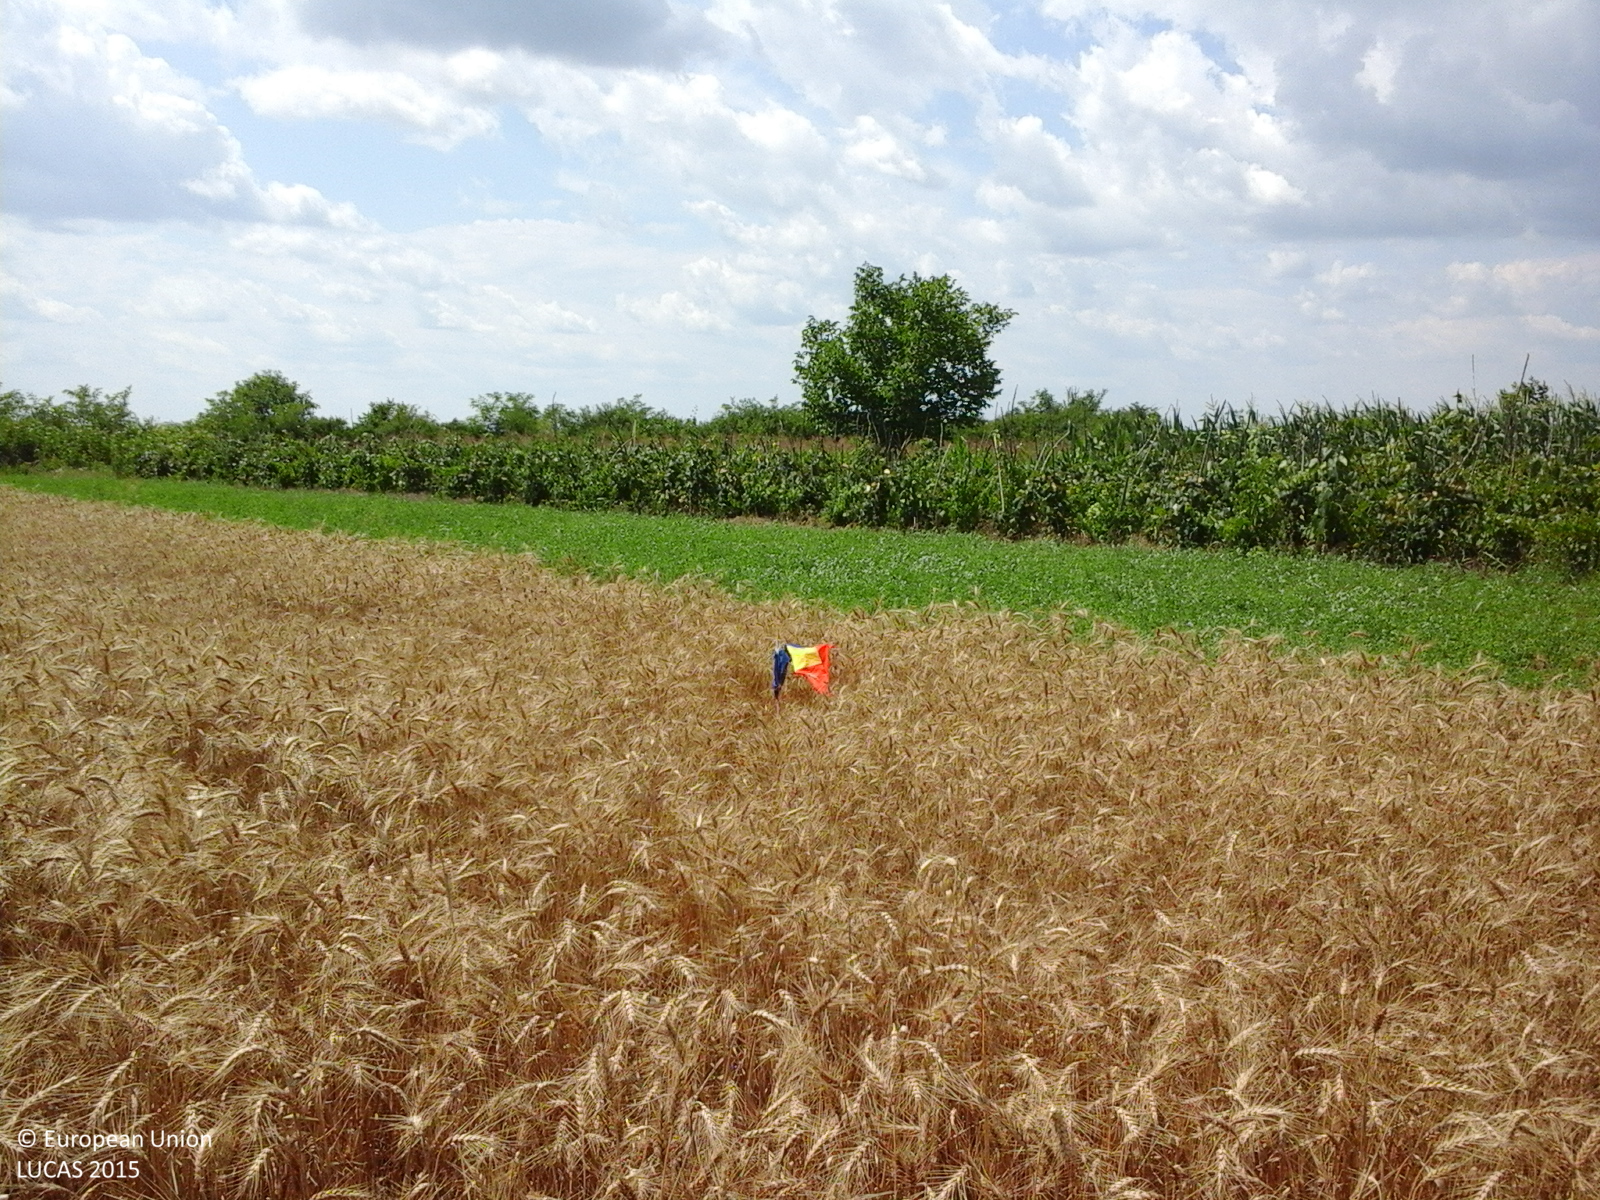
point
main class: Cropland
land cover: Common wheat
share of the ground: > 75 %
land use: Agriculture (excluding fallow land and kitchen gardens)
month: July
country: RO
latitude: 43.9366
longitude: 24.5805
